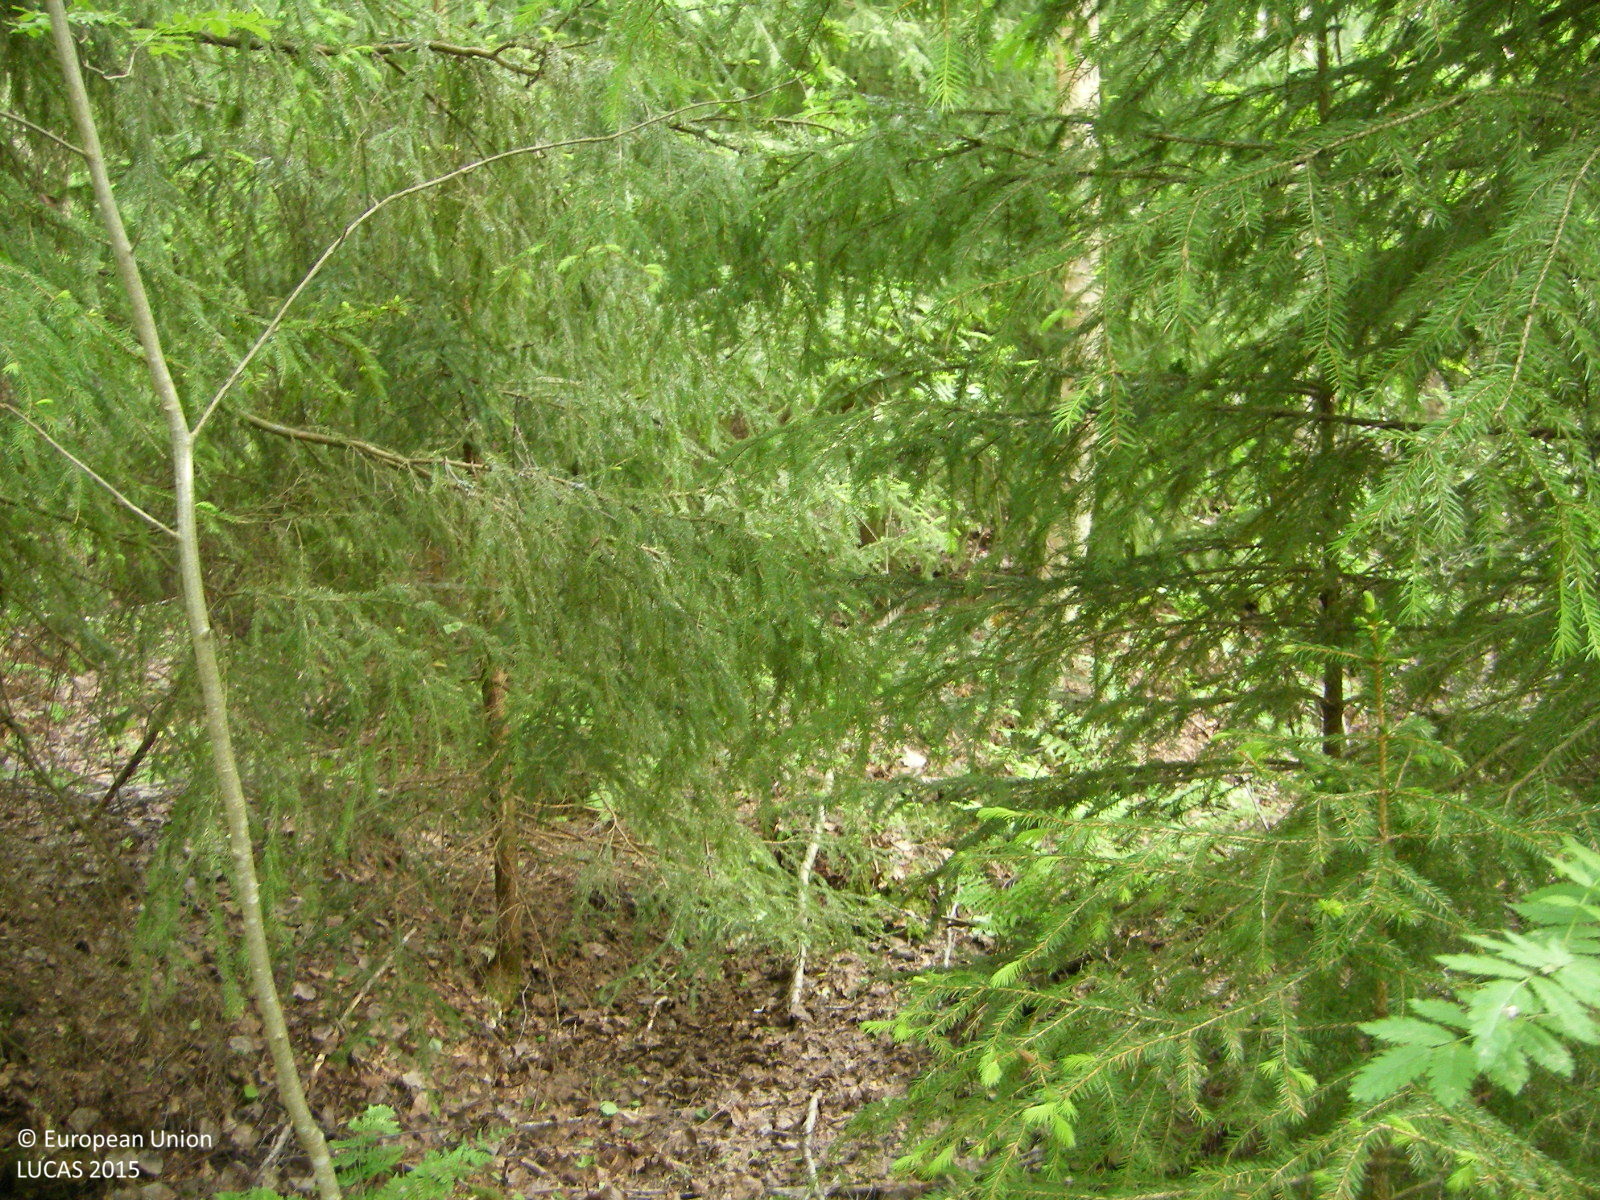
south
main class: Woodland
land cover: Other mixed woodland
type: hemiboreal forest and nemoral coniferous forest and mixed broadleaved-coniferous forest
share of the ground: > 75 %
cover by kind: broadleaved forest trees 70 %, coniferous forest trees 25 %, herbaceous plants 5 %
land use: Forestry
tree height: > 5 m
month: June
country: FI
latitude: 60.3187
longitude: 23.8355
